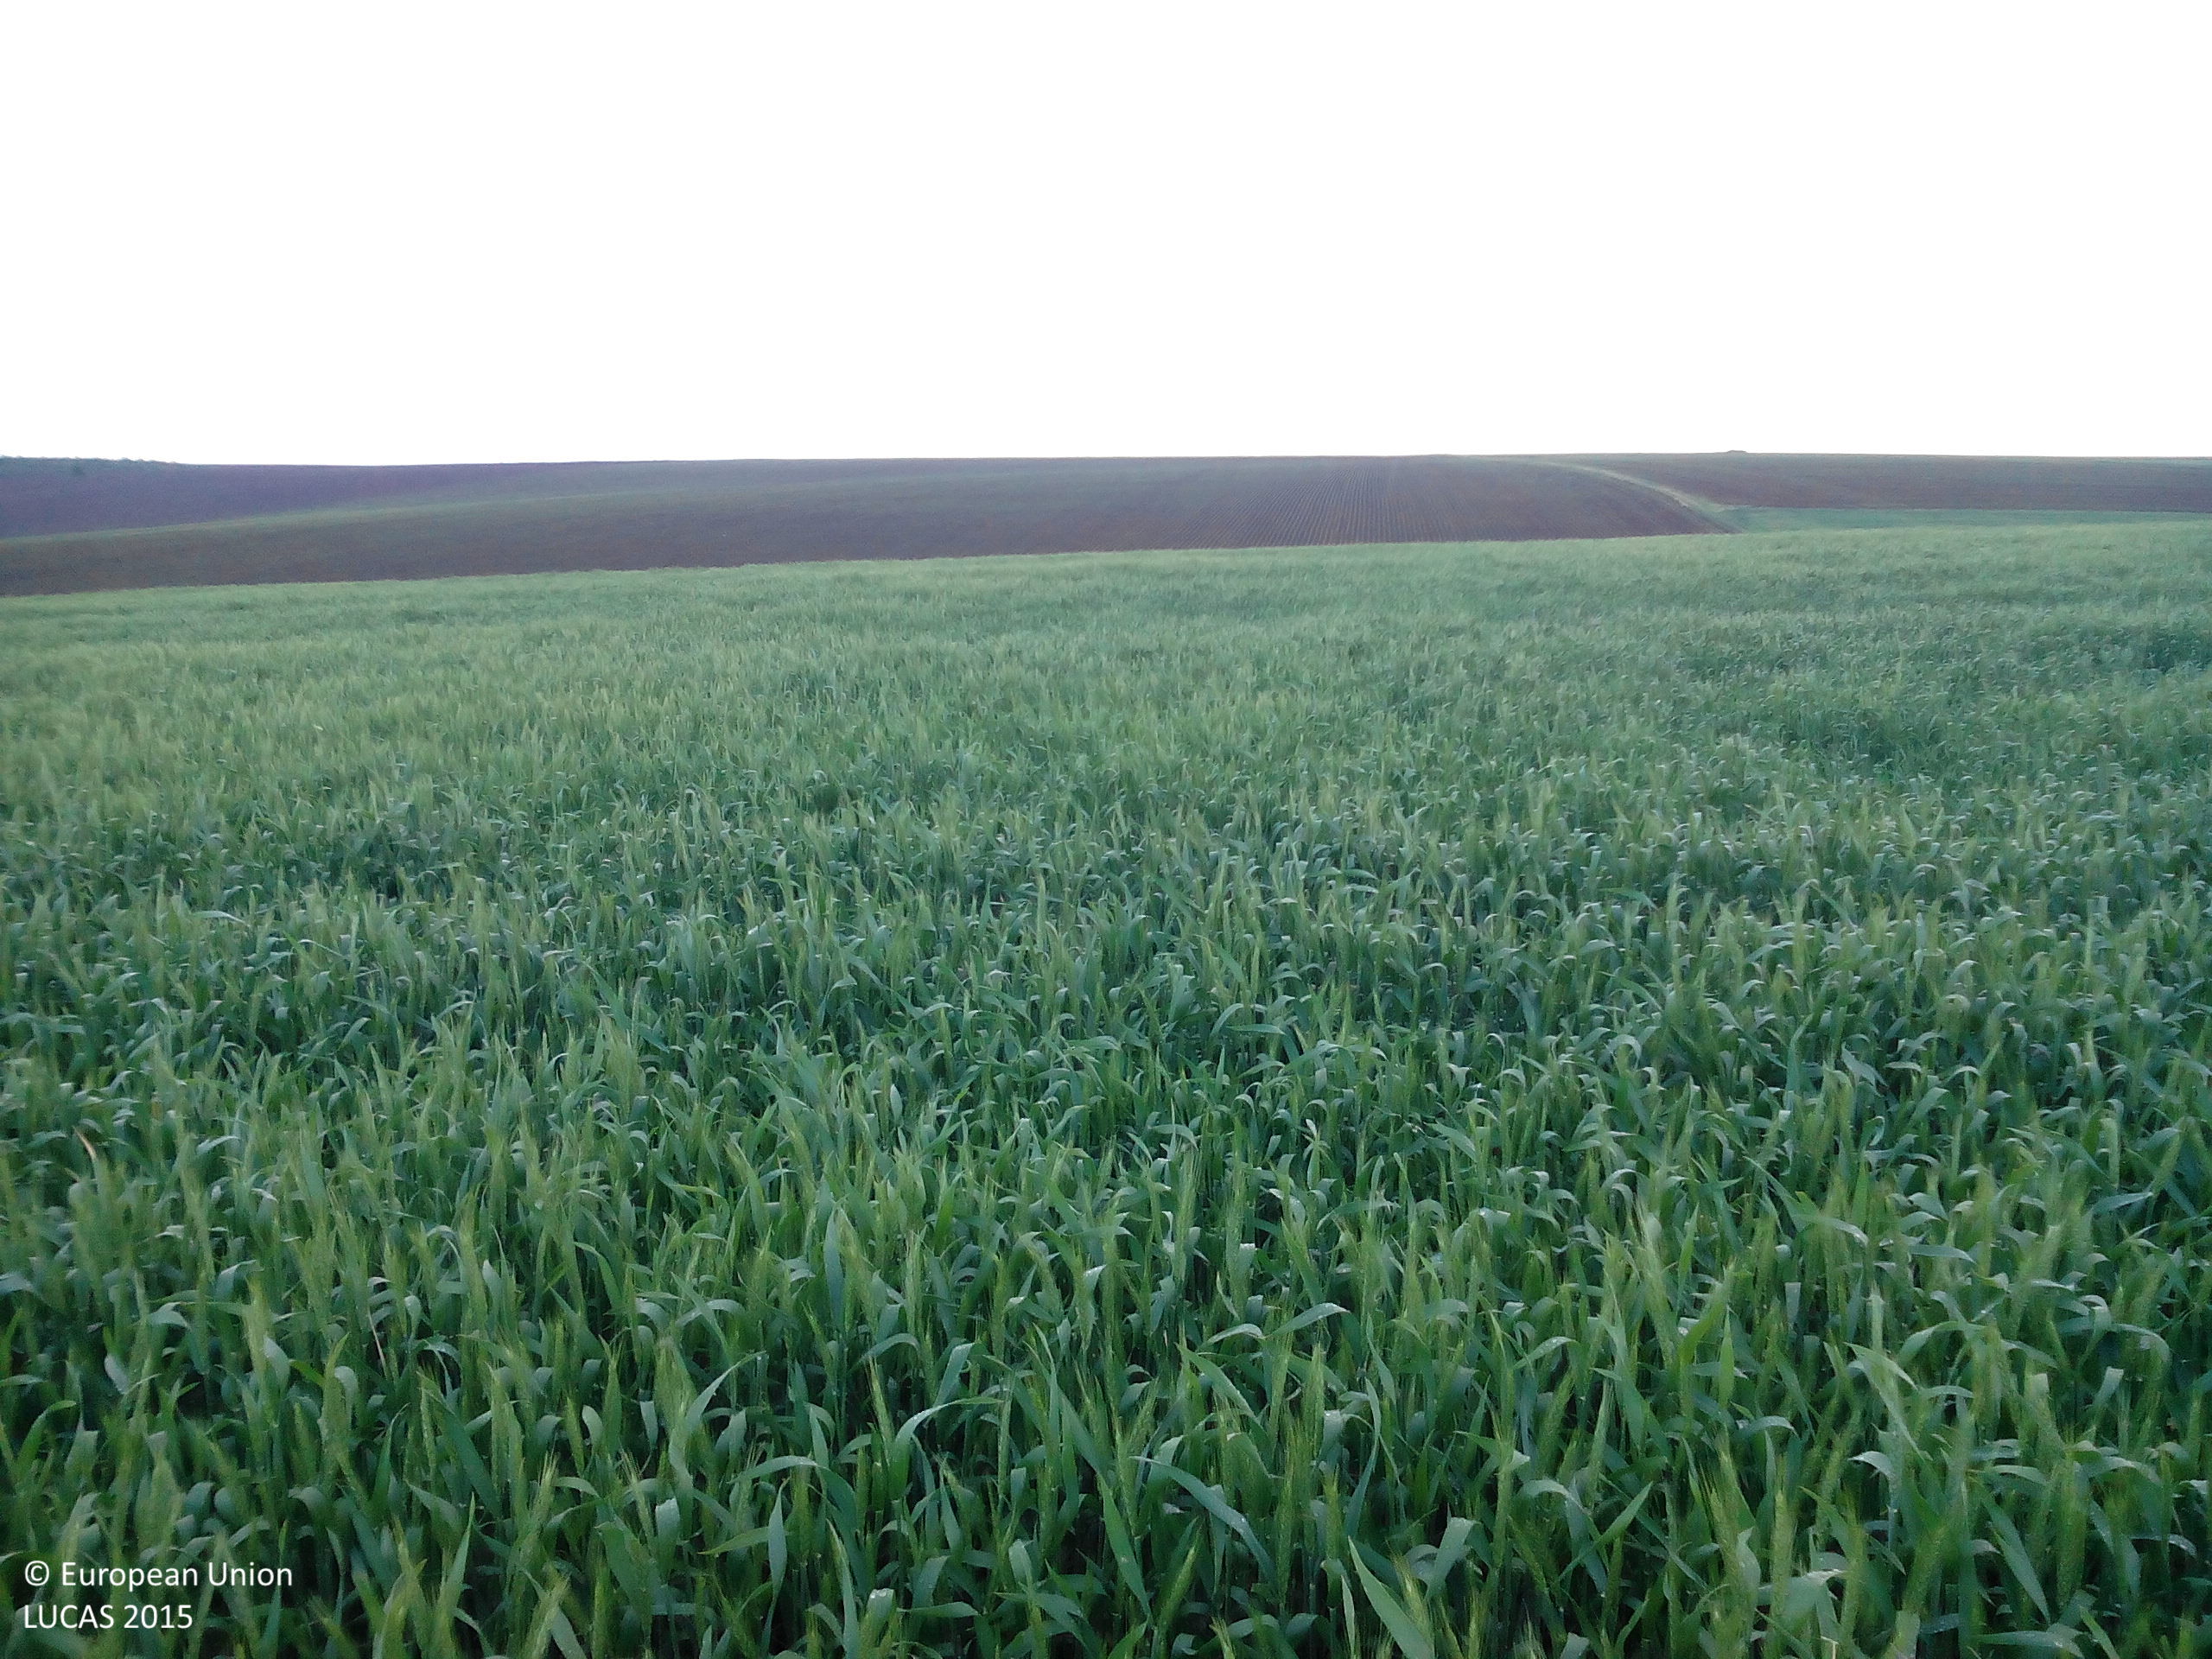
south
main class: Cropland
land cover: Barley
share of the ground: > 75 %
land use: Agriculture (excluding fallow land and kitchen gardens)
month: May
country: BG
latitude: 43.5124
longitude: 23.8177
